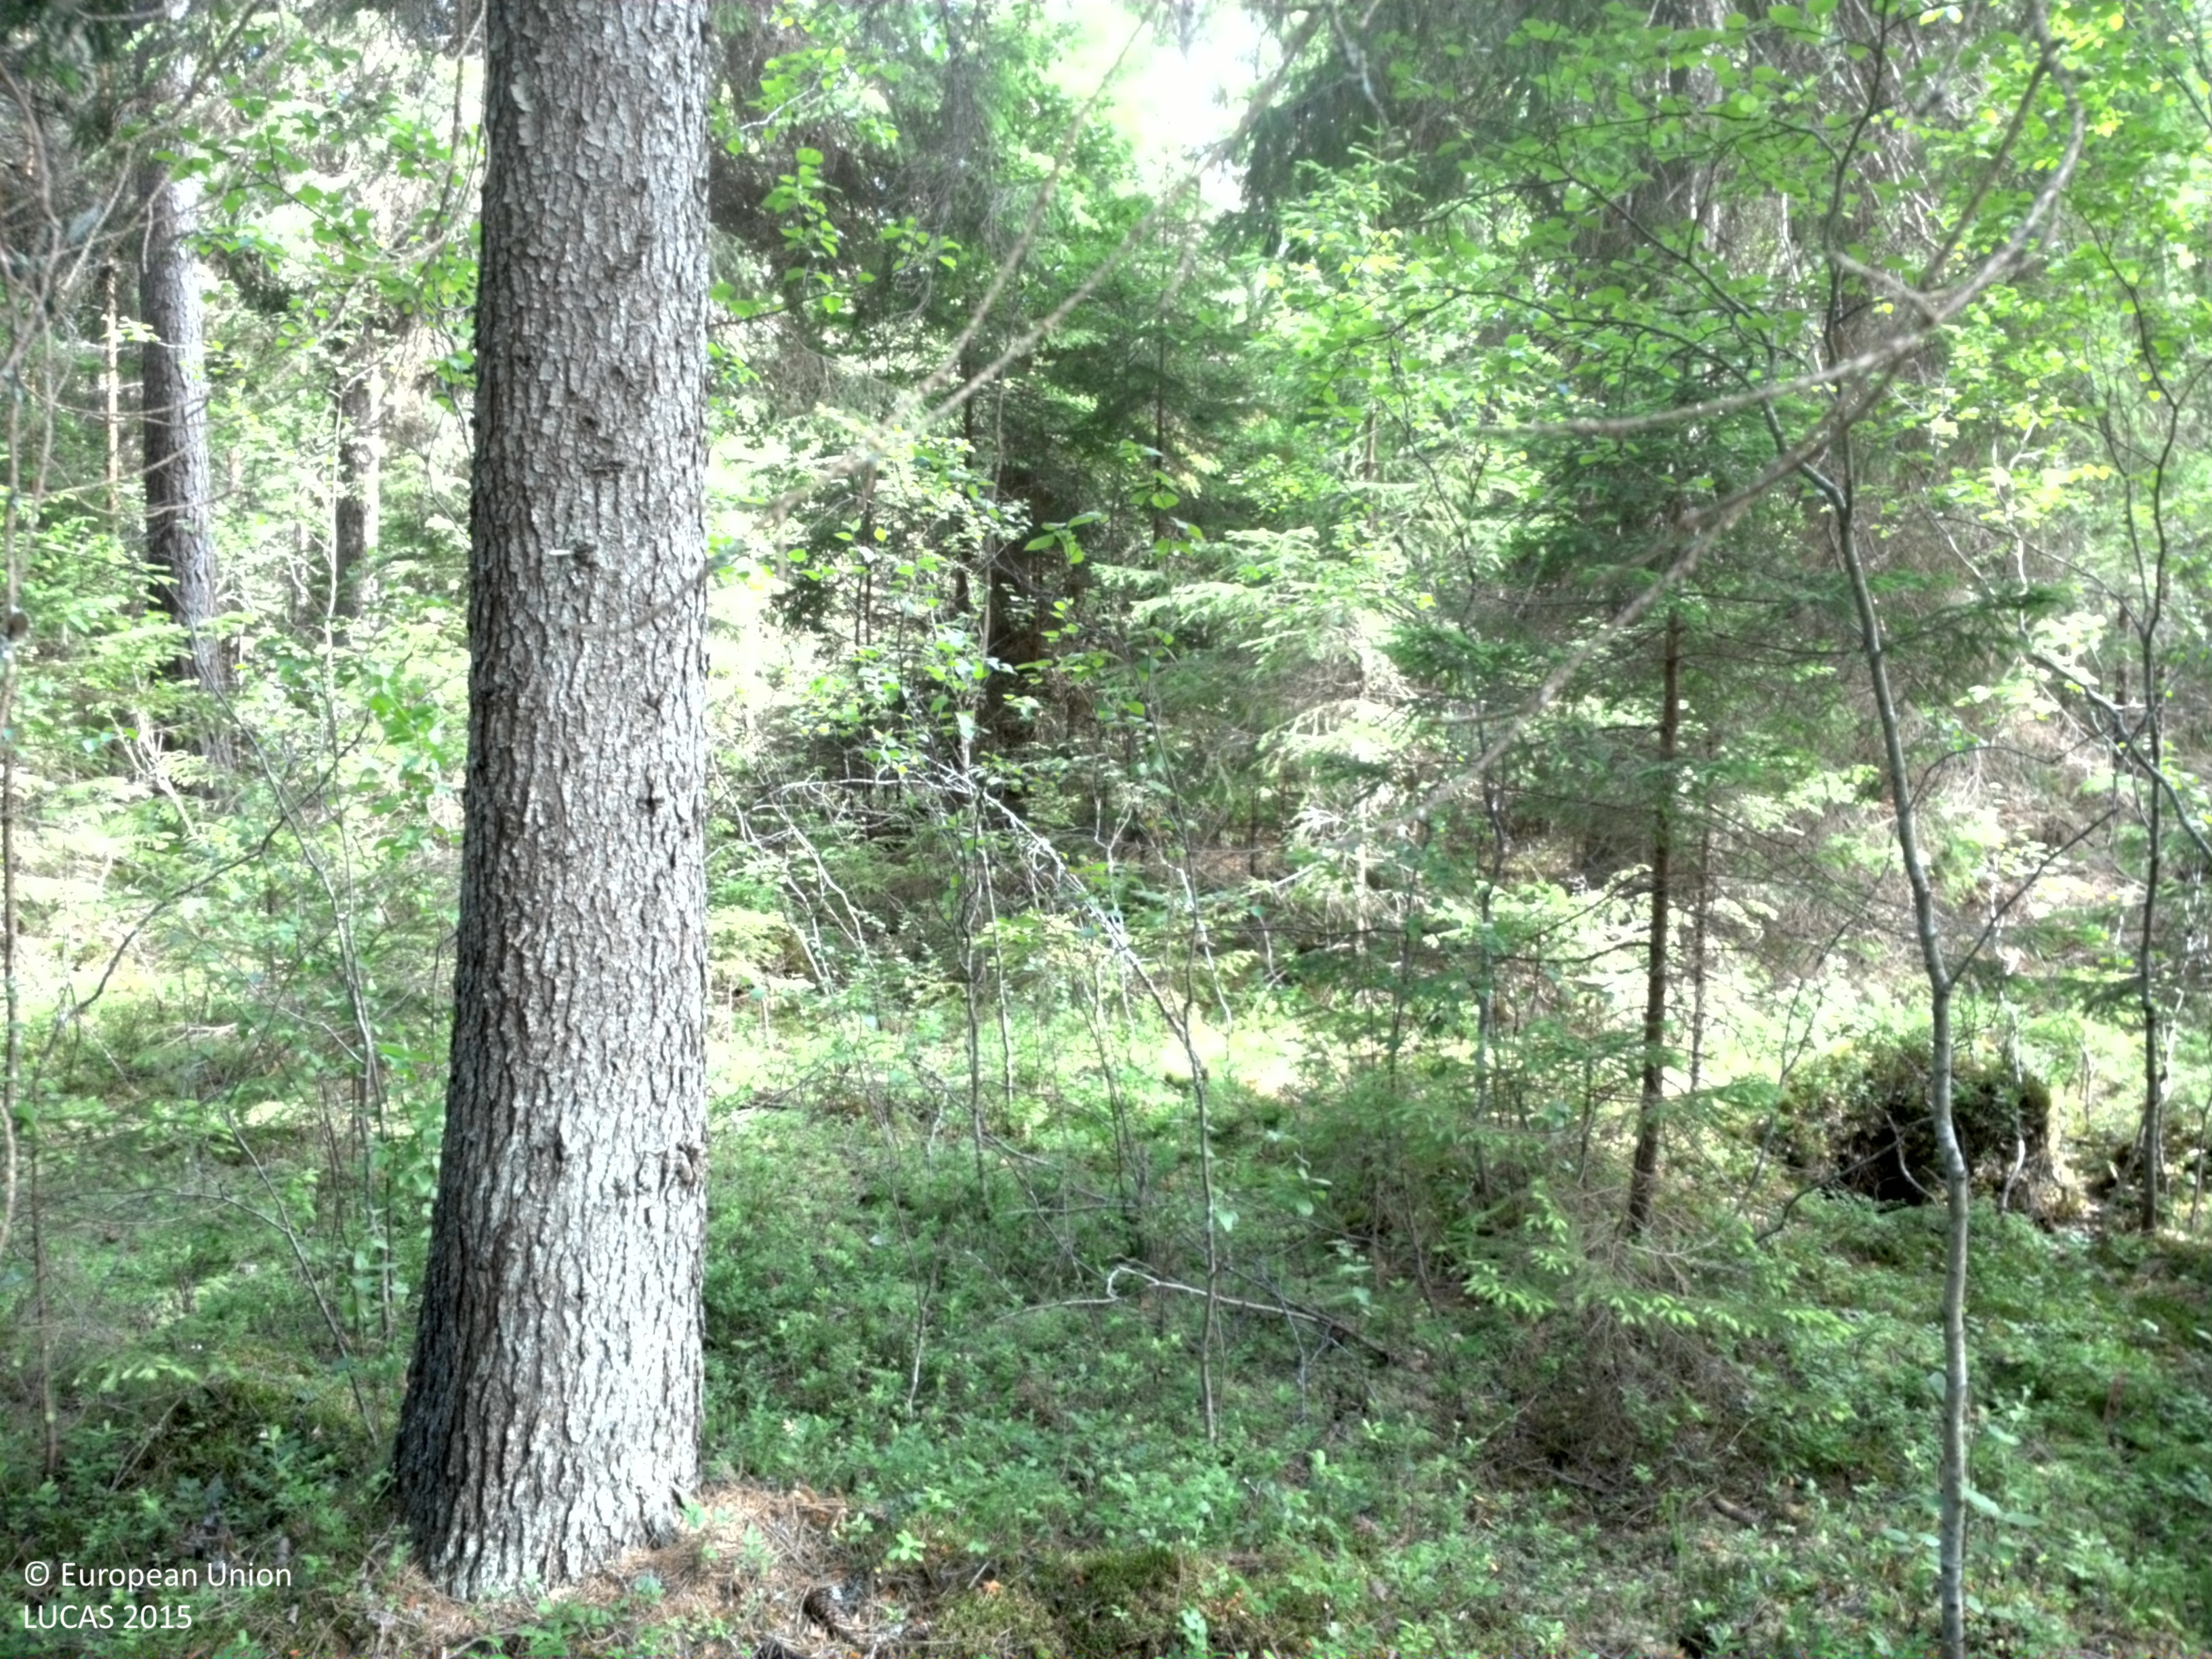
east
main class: Woodland
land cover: Spruce dominated coniferous woodland
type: boreal forest
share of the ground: > 75 %
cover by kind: coniferous forest trees 70 %, herbaceous plants 20 %, broadleaved forest trees 10 %
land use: Forestry
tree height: > 5 m
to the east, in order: Spruce dominated coniferous woodland; Other coniferous woodland; Pine dominated coniferous woodland; Spruce dominated mixed woodland; Spruce dominated coniferous woodland
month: July
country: SE
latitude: 60.0228
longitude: 17.0431
